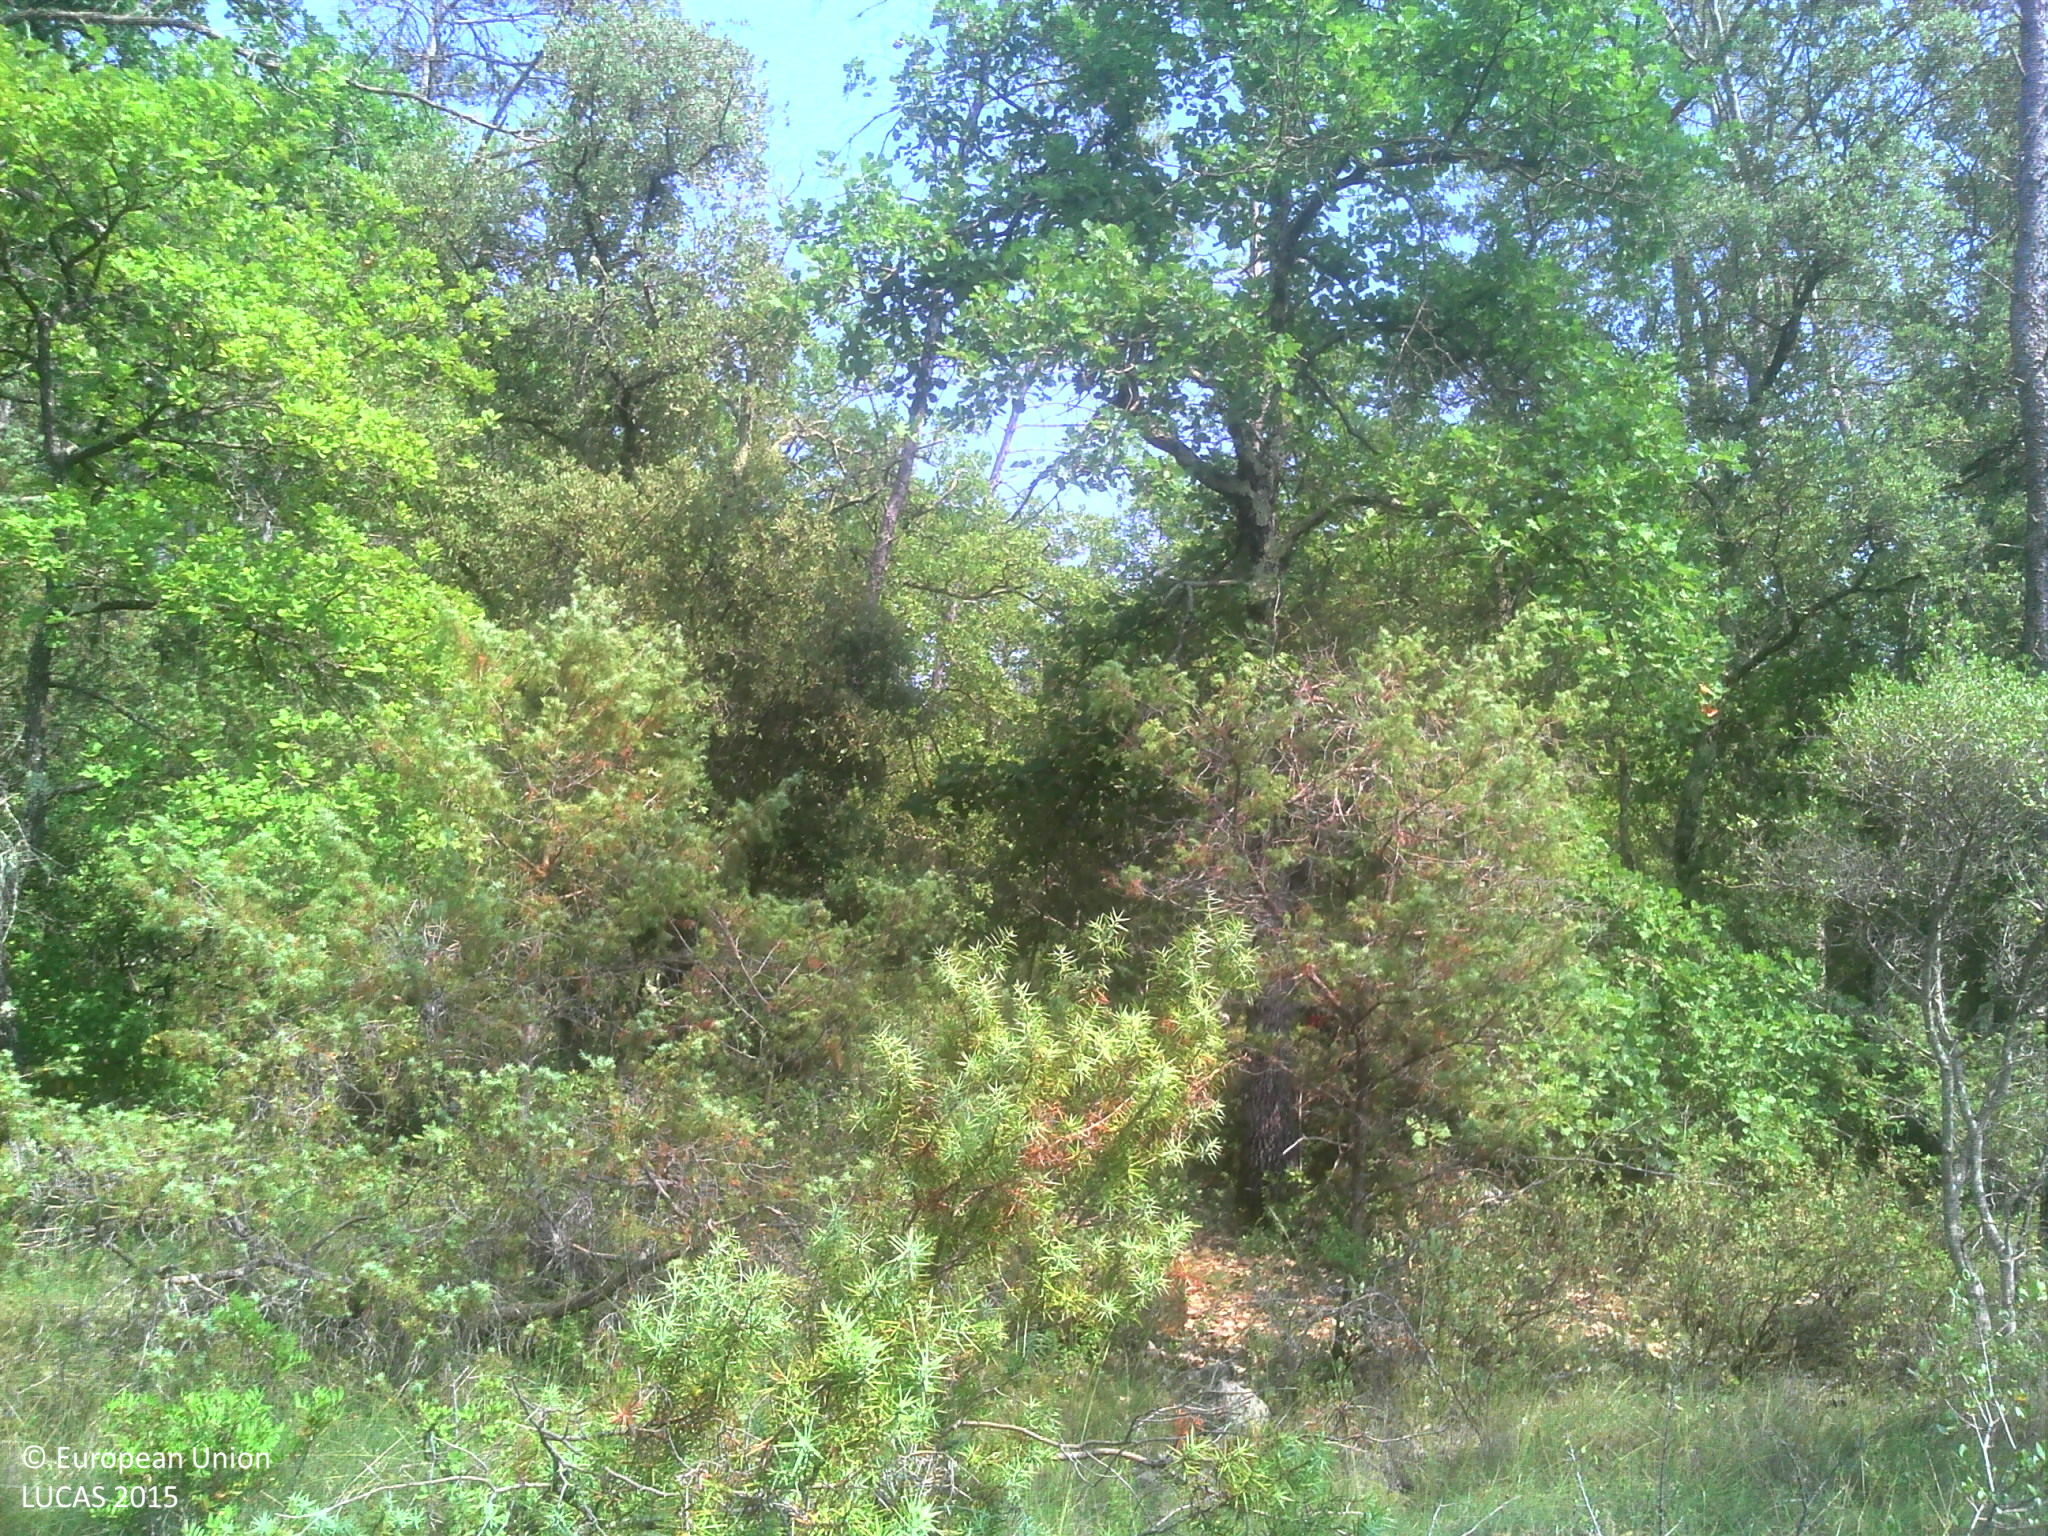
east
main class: Woodland
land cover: Pine dominated mixed woodland
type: coniferous forest of the mediterranean region
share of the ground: > 75 %
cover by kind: broadleaved forest trees 40 %, coniferous forest trees 35 %, shrubs 20 %, herbaceous plants 5 %
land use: Semi-natural and natural areas not in use
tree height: > 5 m
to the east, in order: Pine dominated mixed woodland; Tracks; Pine dominated mixed woodland; Tracks; Pine dominated mixed woodland; Tracks; Pine dominated mixed woodland; Dry stone walls; Pine dominated mixed woodland
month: July
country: FR
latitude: 43.4561
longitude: 6.3630
